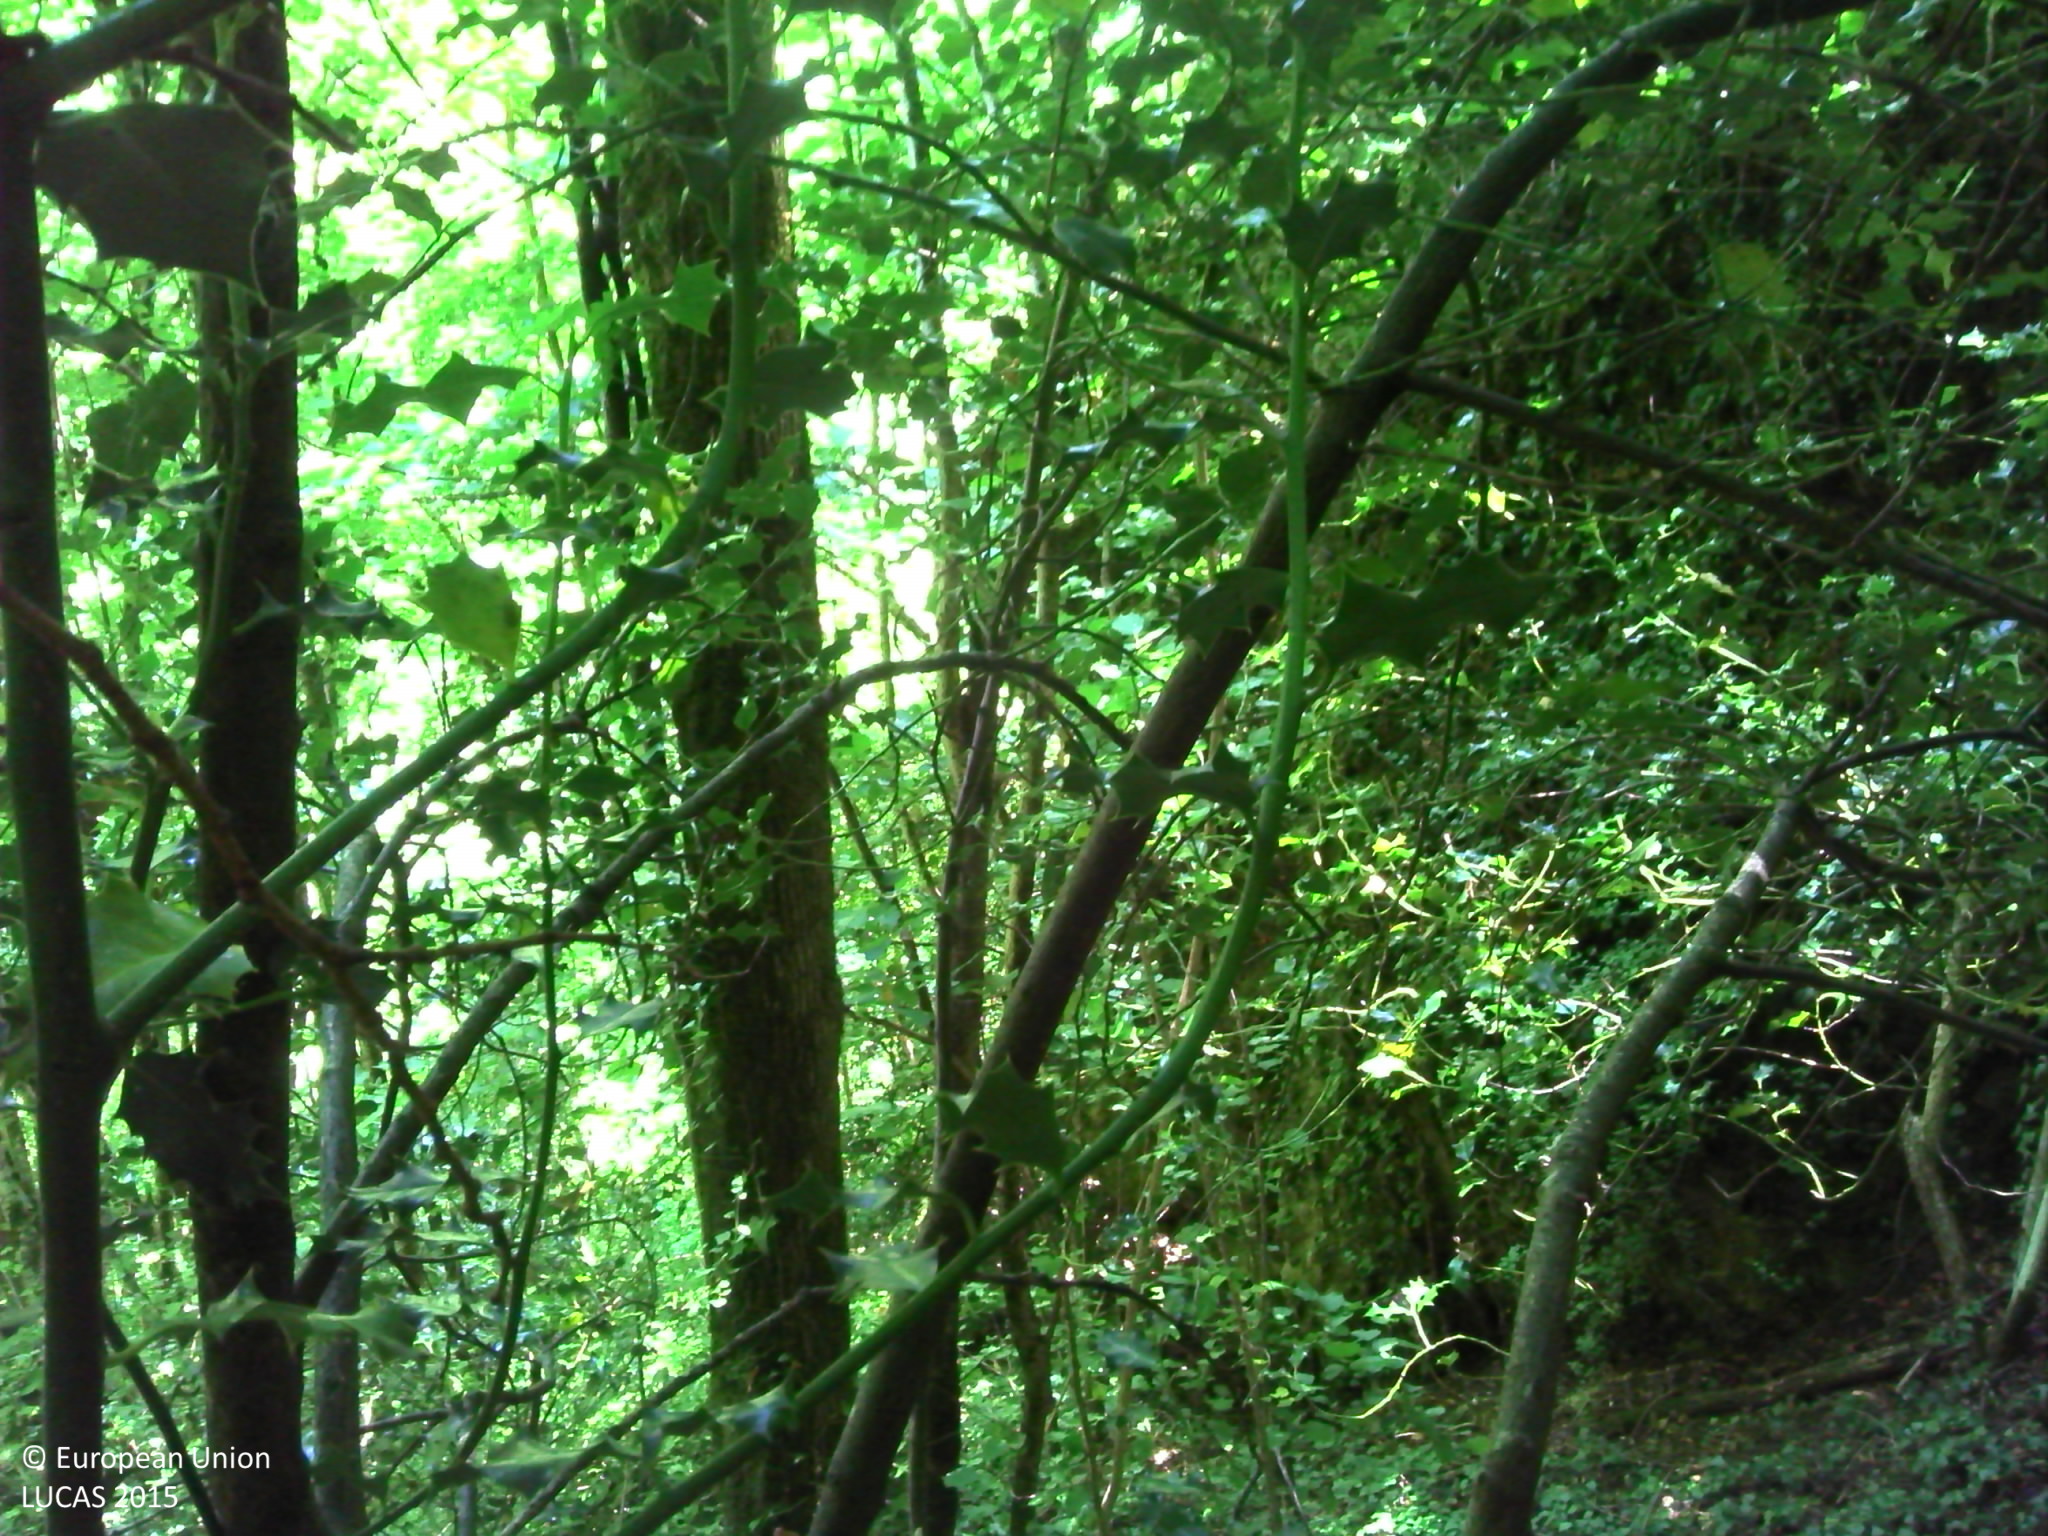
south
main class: Woodland
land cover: Broadleaved woodland
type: mesophytic deciduous forest
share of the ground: > 75 %
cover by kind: broadleaved forest trees 70 %, shrubs 25 %, herbaceous plants 5 %
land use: Semi-natural and natural areas not in use
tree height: > 5 m
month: June
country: FR
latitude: 45.1278
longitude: 2.4858
